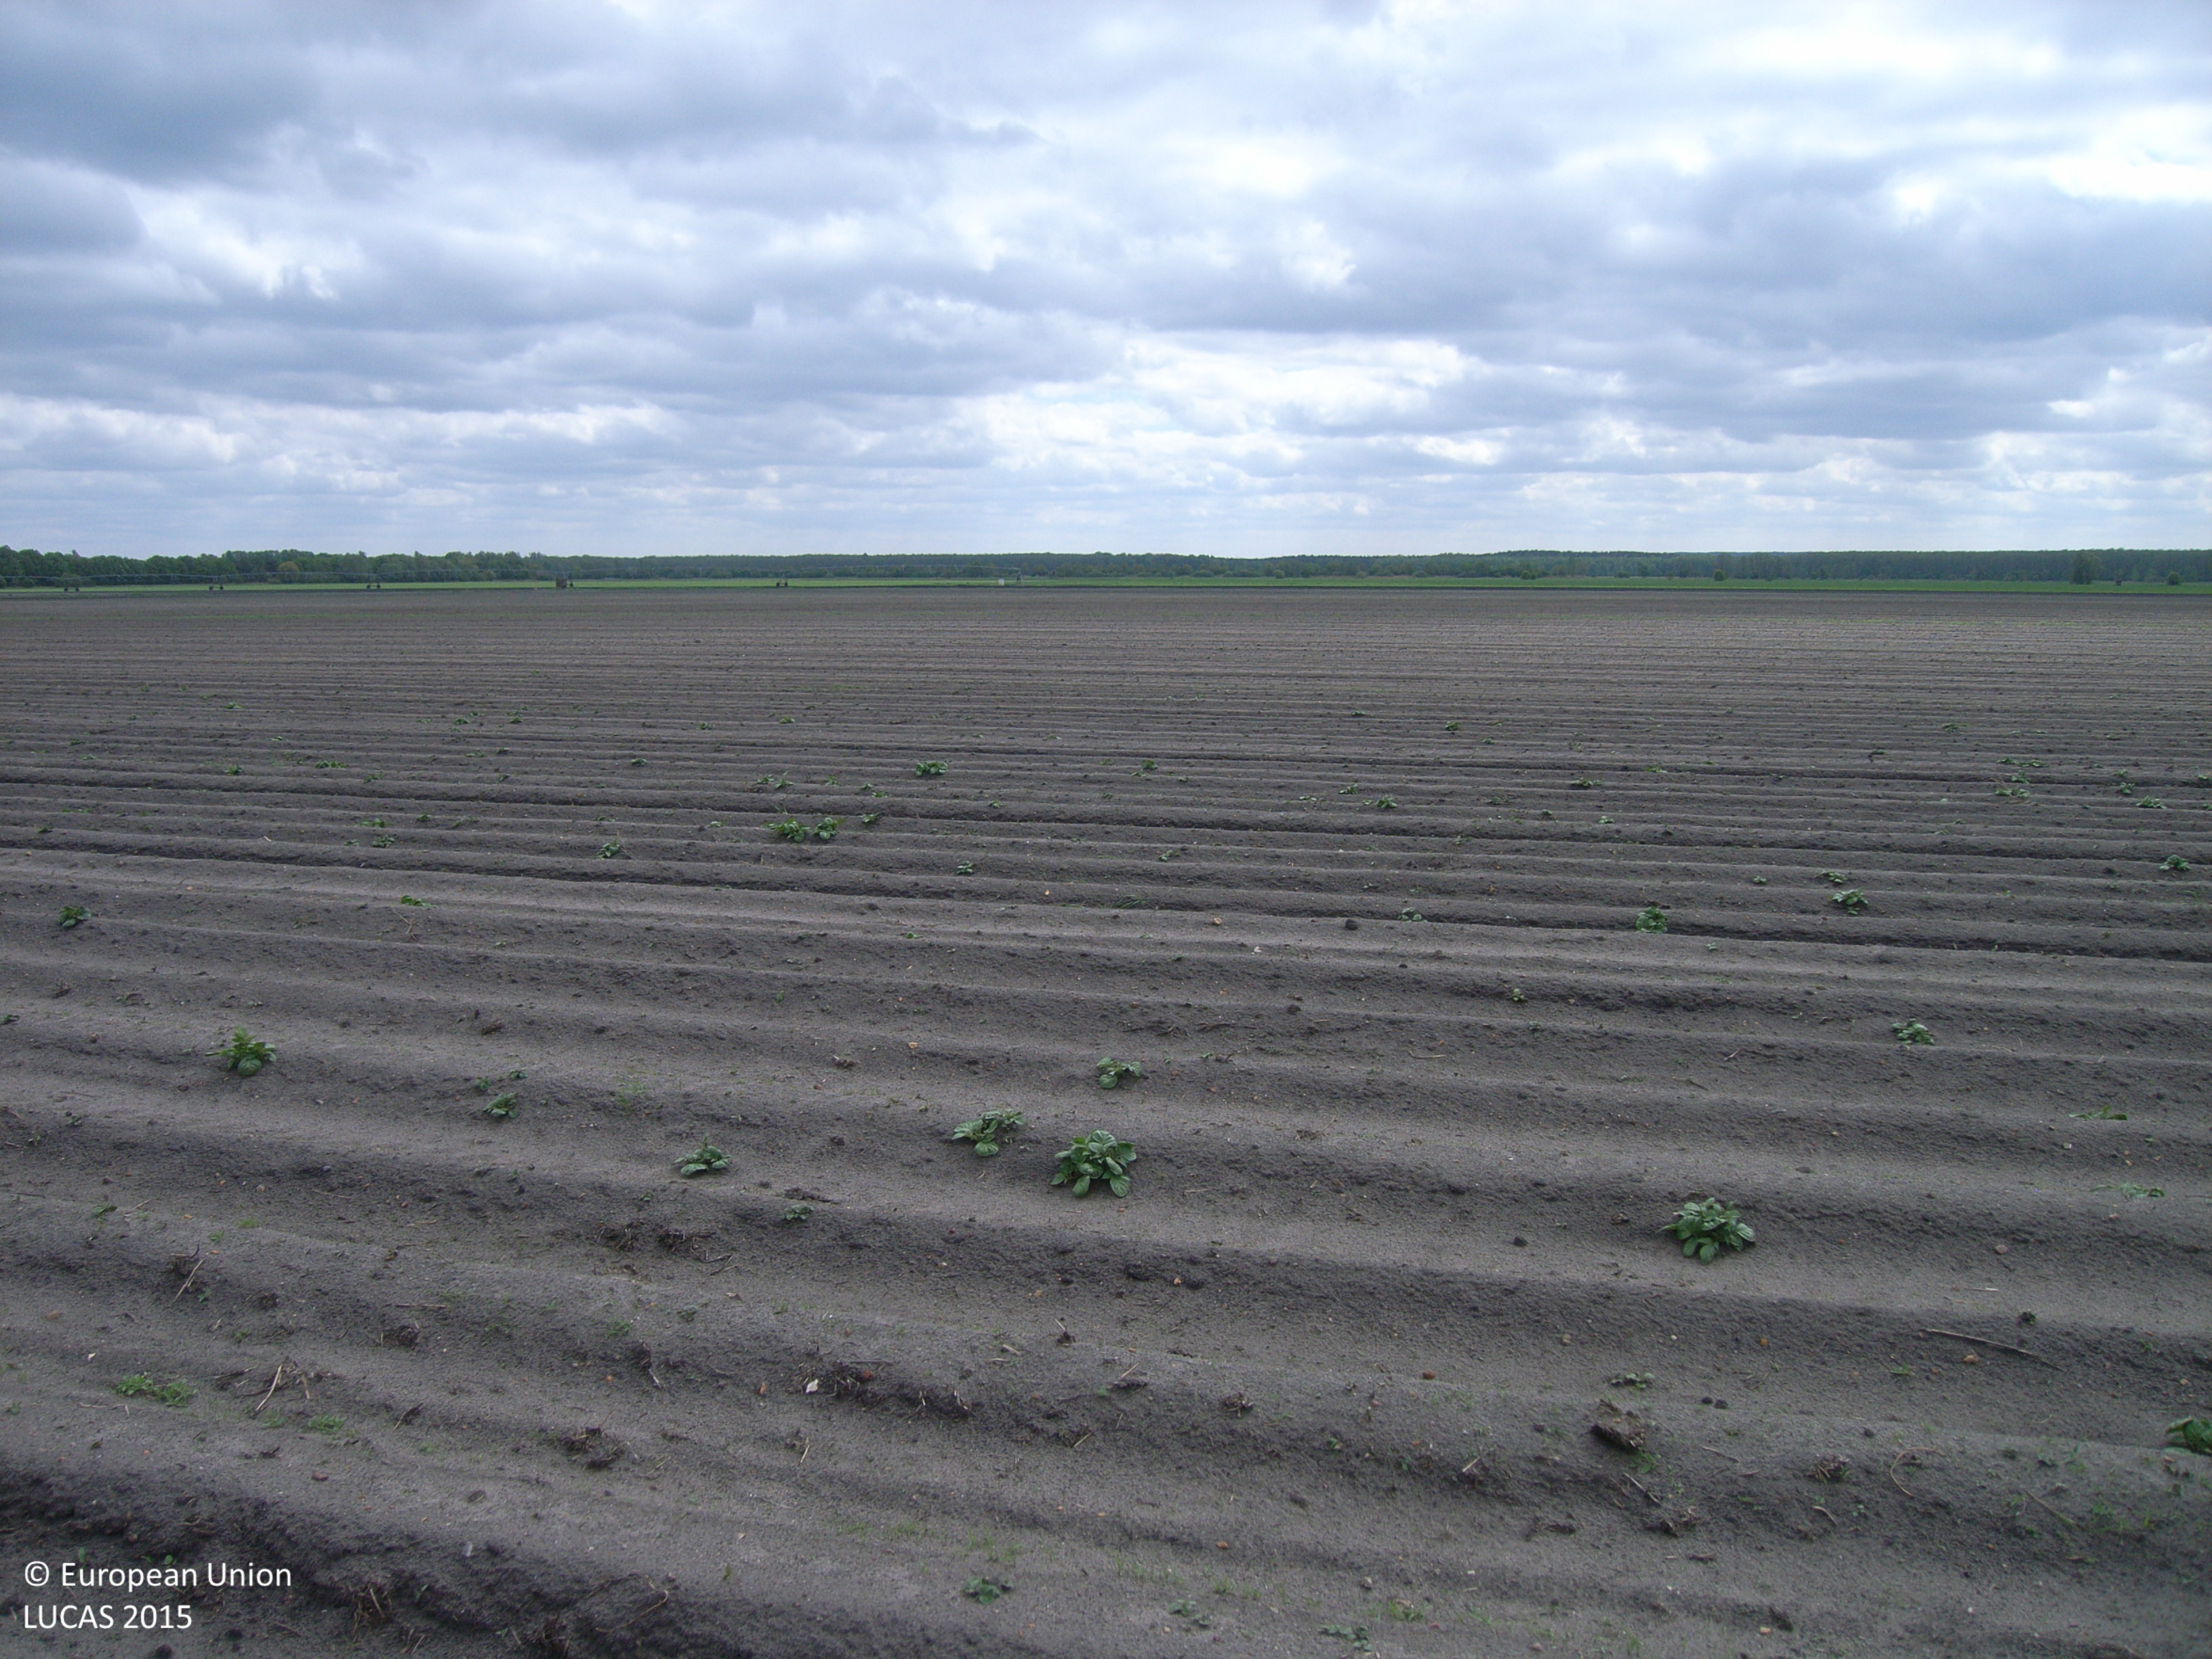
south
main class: Cropland
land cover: Potatoes
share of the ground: < 10 %
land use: Agriculture (excluding fallow land and kitchen gardens)
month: May
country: DE
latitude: 52.0538
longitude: 13.5733
